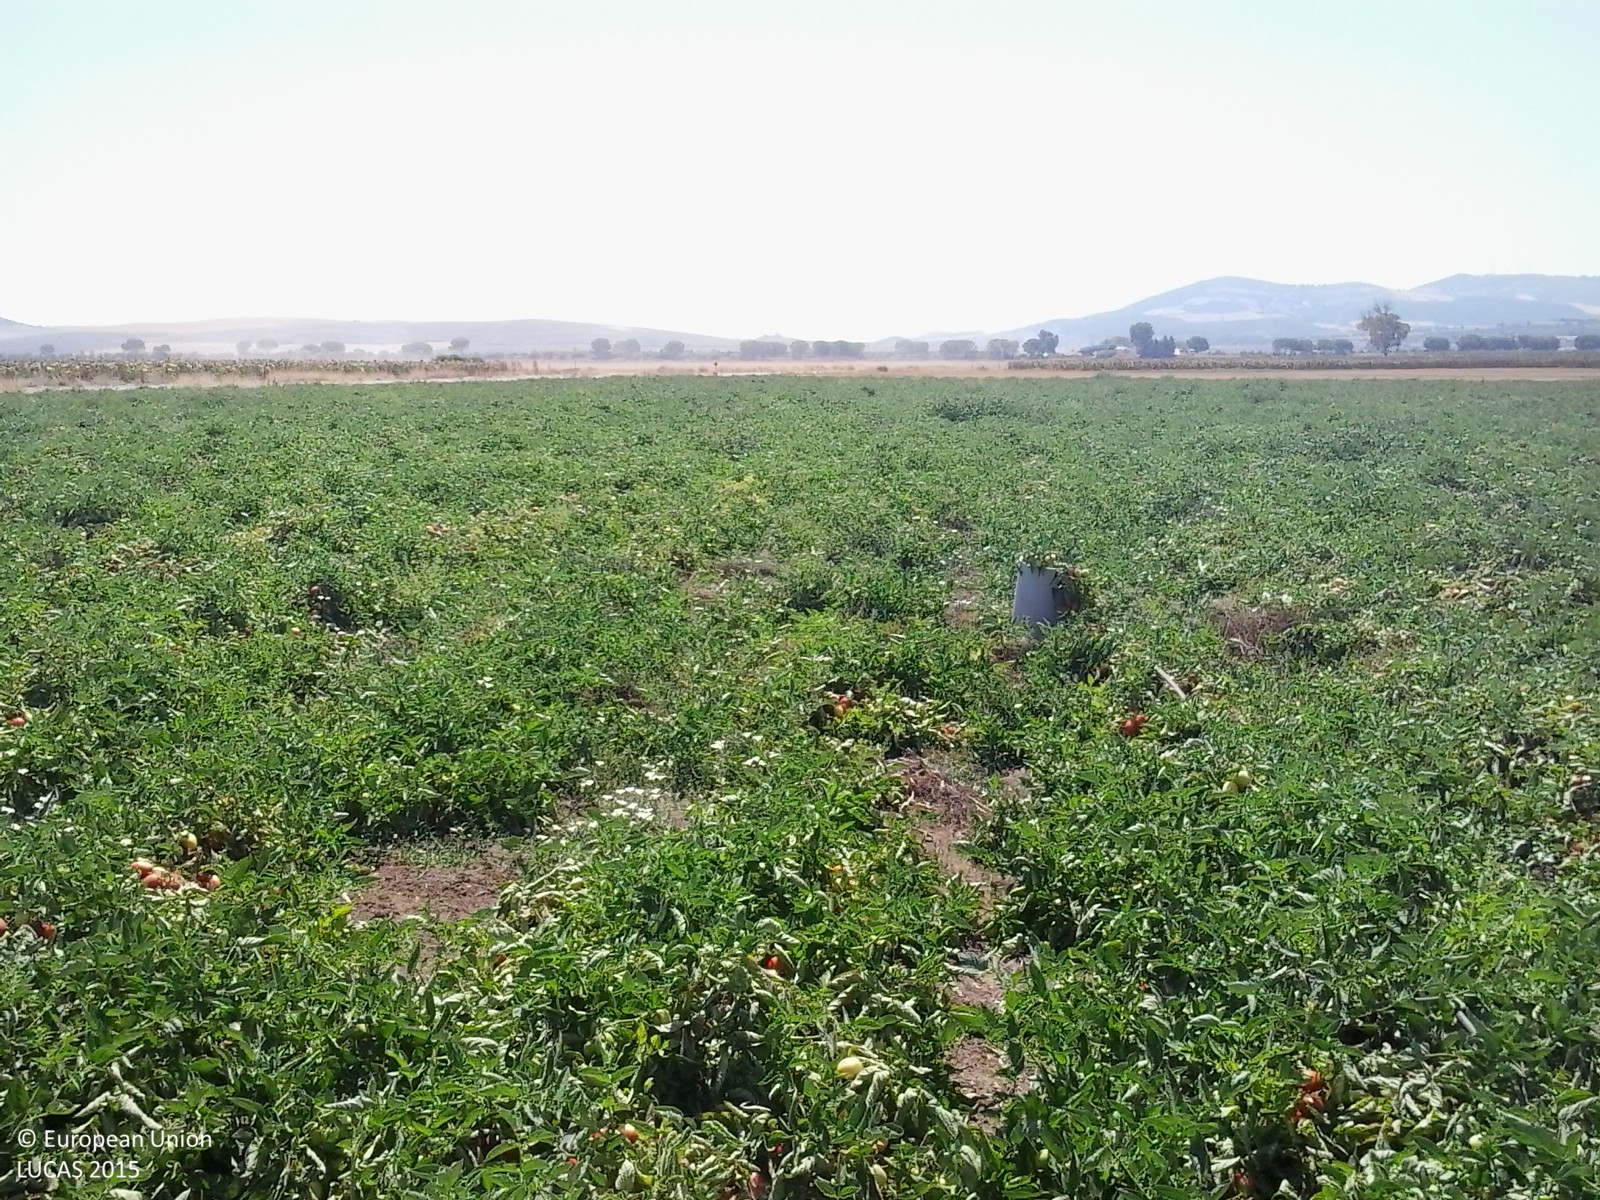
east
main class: Cropland
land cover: Tomatoes
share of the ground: > 75 %
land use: Agriculture (excluding fallow land and kitchen gardens)
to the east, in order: Tomatoes; Tracks; Sunflower; Grass margins; Common wheat
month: July
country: ES
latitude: 36.8809
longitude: -6.0019
